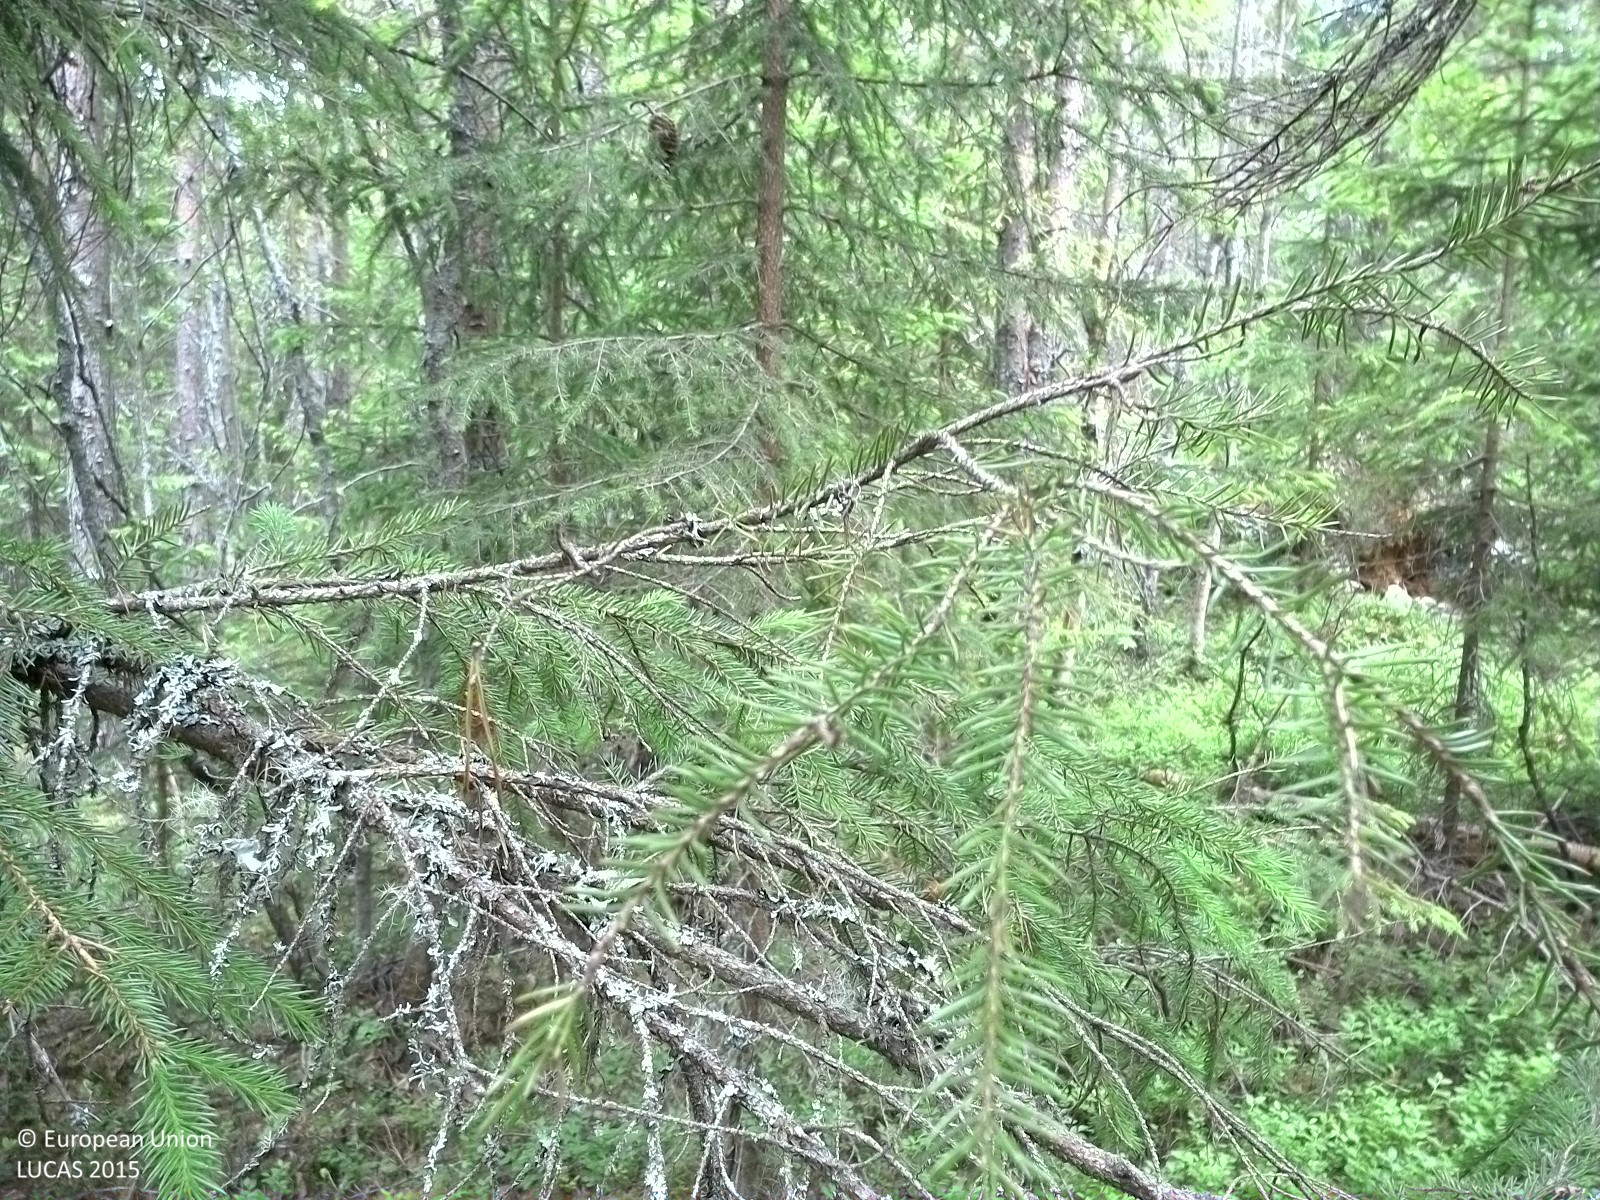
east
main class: Woodland
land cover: Spruce dominated mixed woodland
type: boreal forest
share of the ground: 50 - 75 %
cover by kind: coniferous forest trees 40 %, shrubs 30 %, broadleaved forest trees 25 %, herbaceous plants 5 %
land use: Forestry
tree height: > 5 m
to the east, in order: Spruce dominated mixed woodland; Pine dominated coniferous woodland; Pine dominated mixed woodland; Spruce dominated coniferous woodland; Ditches and canals; Spruce dominated coniferous woodland
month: July
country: SE
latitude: 62.1801
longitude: 16.9534
